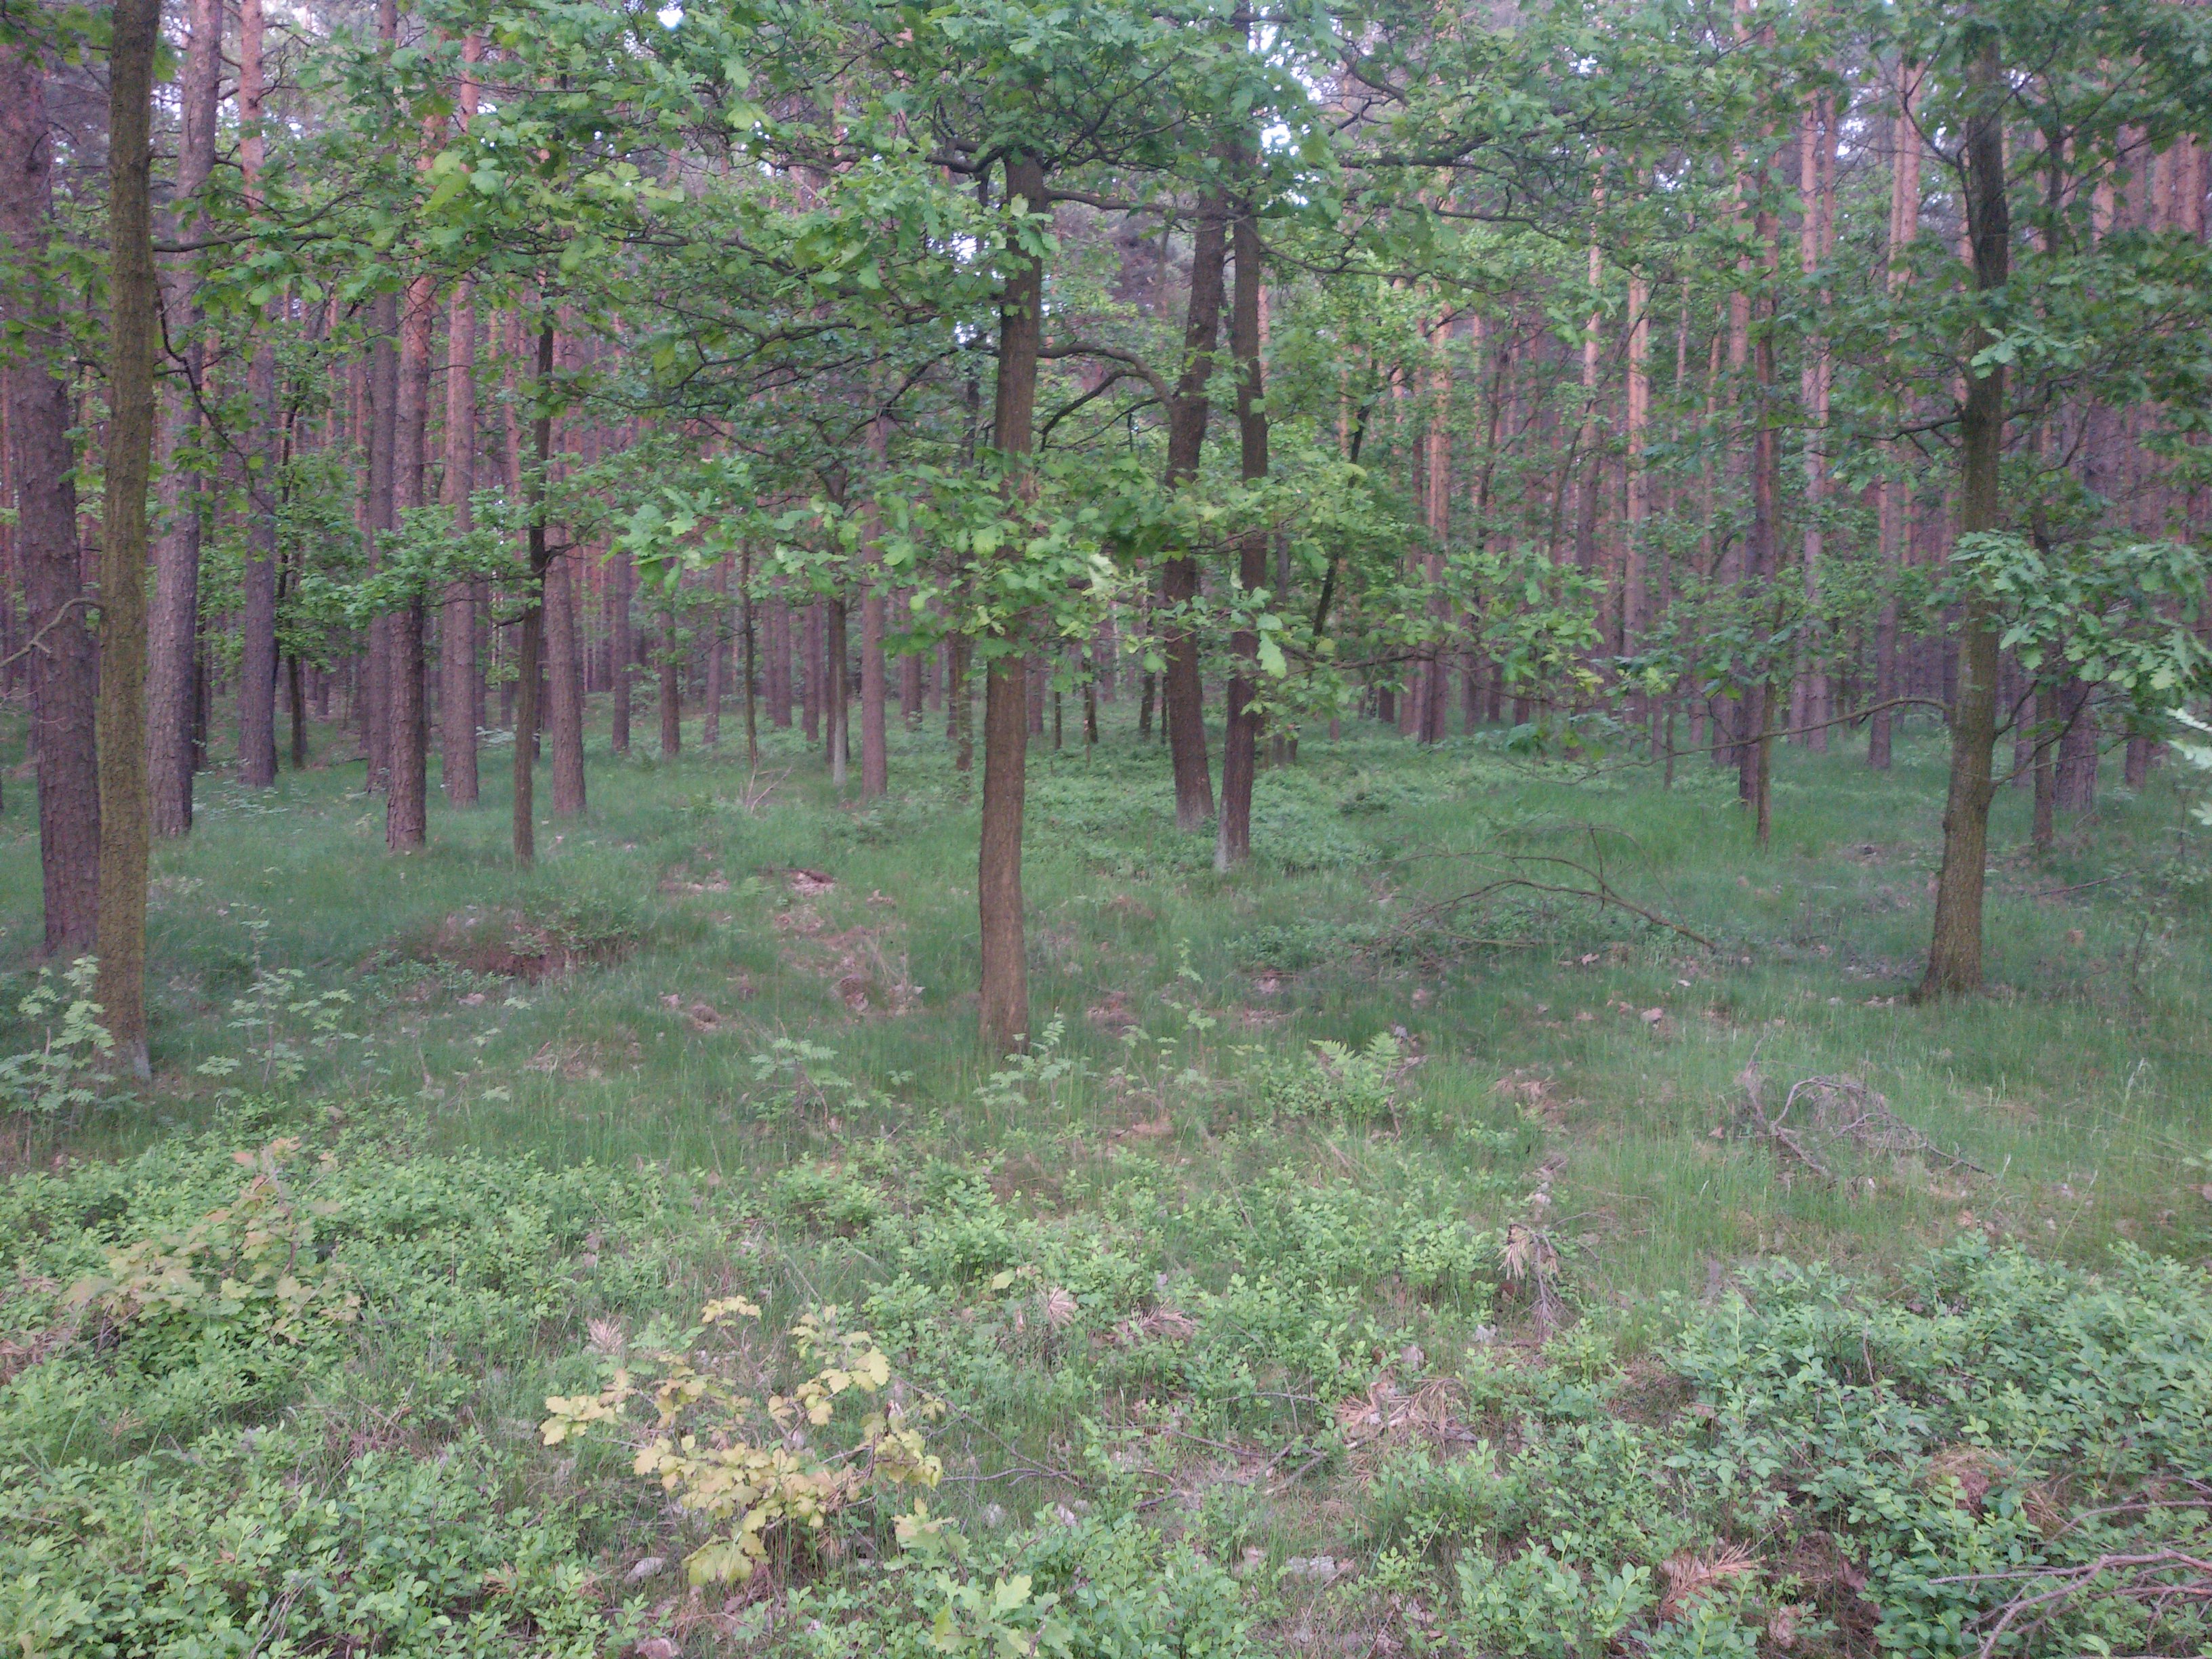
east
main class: Woodland
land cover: Pine dominated mixed woodland
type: hemiboreal forest and nemoral coniferous forest and mixed broadleaved-coniferous forest
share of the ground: > 75 %
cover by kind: coniferous forest trees 60 %, broadleaved forest trees 25 %, herbaceous plants 15 %
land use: Forestry
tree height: > 5 m
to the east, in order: Pine dominated mixed woodland
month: May
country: PL
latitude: 51.2414
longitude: 15.4904
